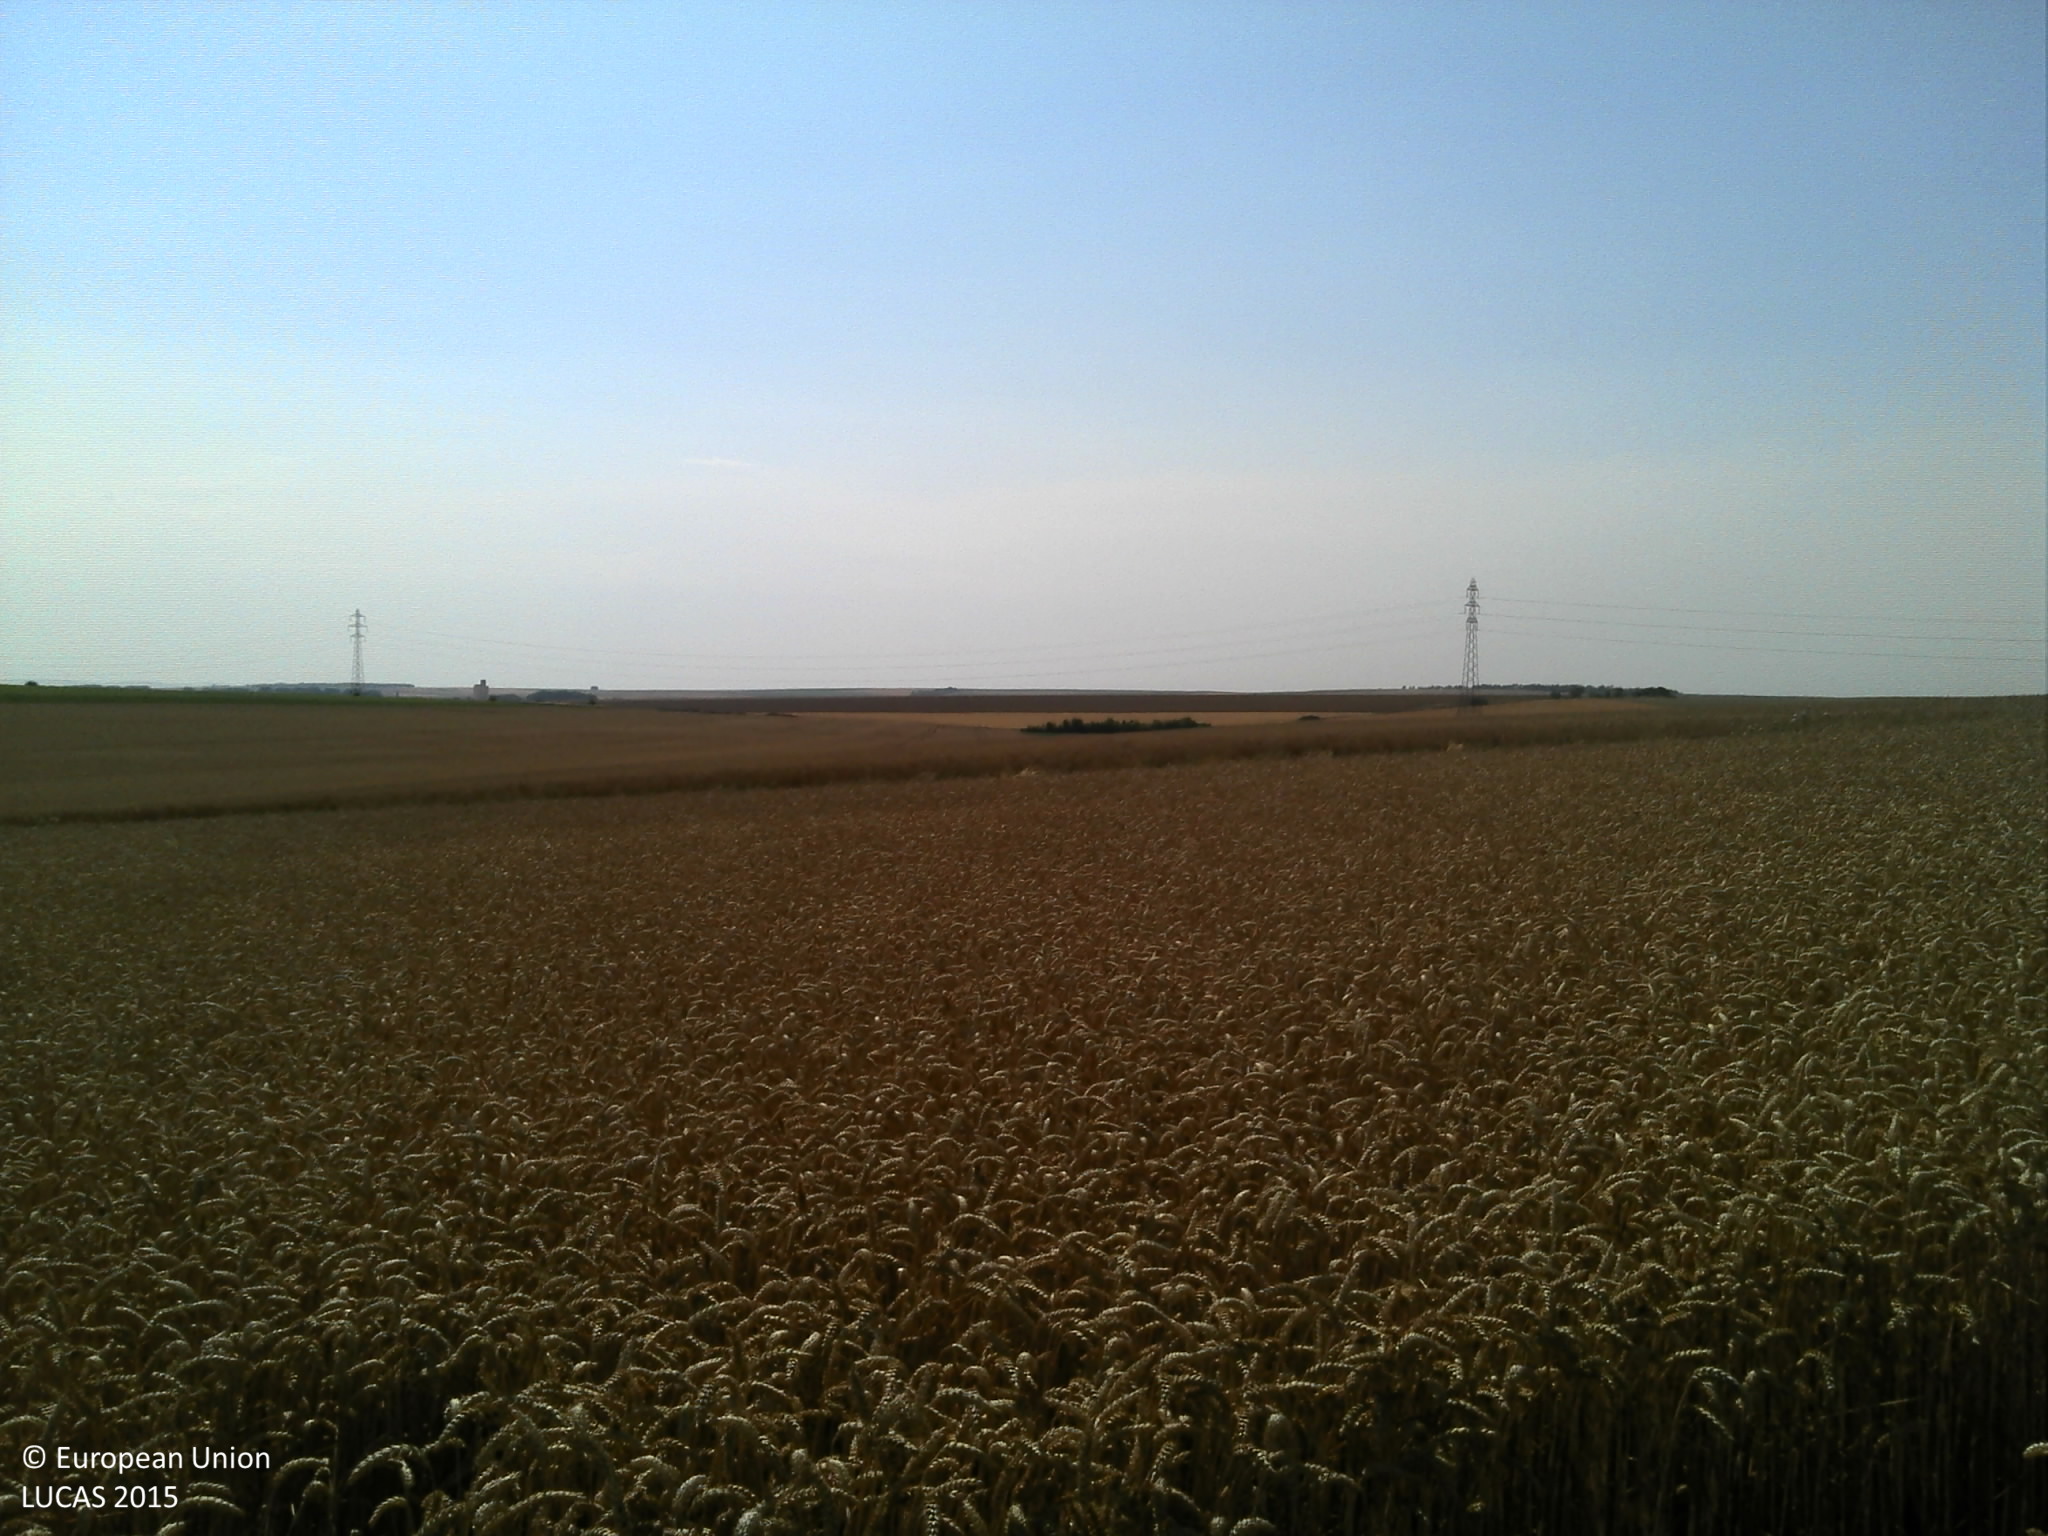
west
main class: Cropland
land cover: Common wheat
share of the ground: > 75 %
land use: Agriculture (excluding fallow land and kitchen gardens)
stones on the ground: < 10 %
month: July
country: FR
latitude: 49.4632
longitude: 4.2696
